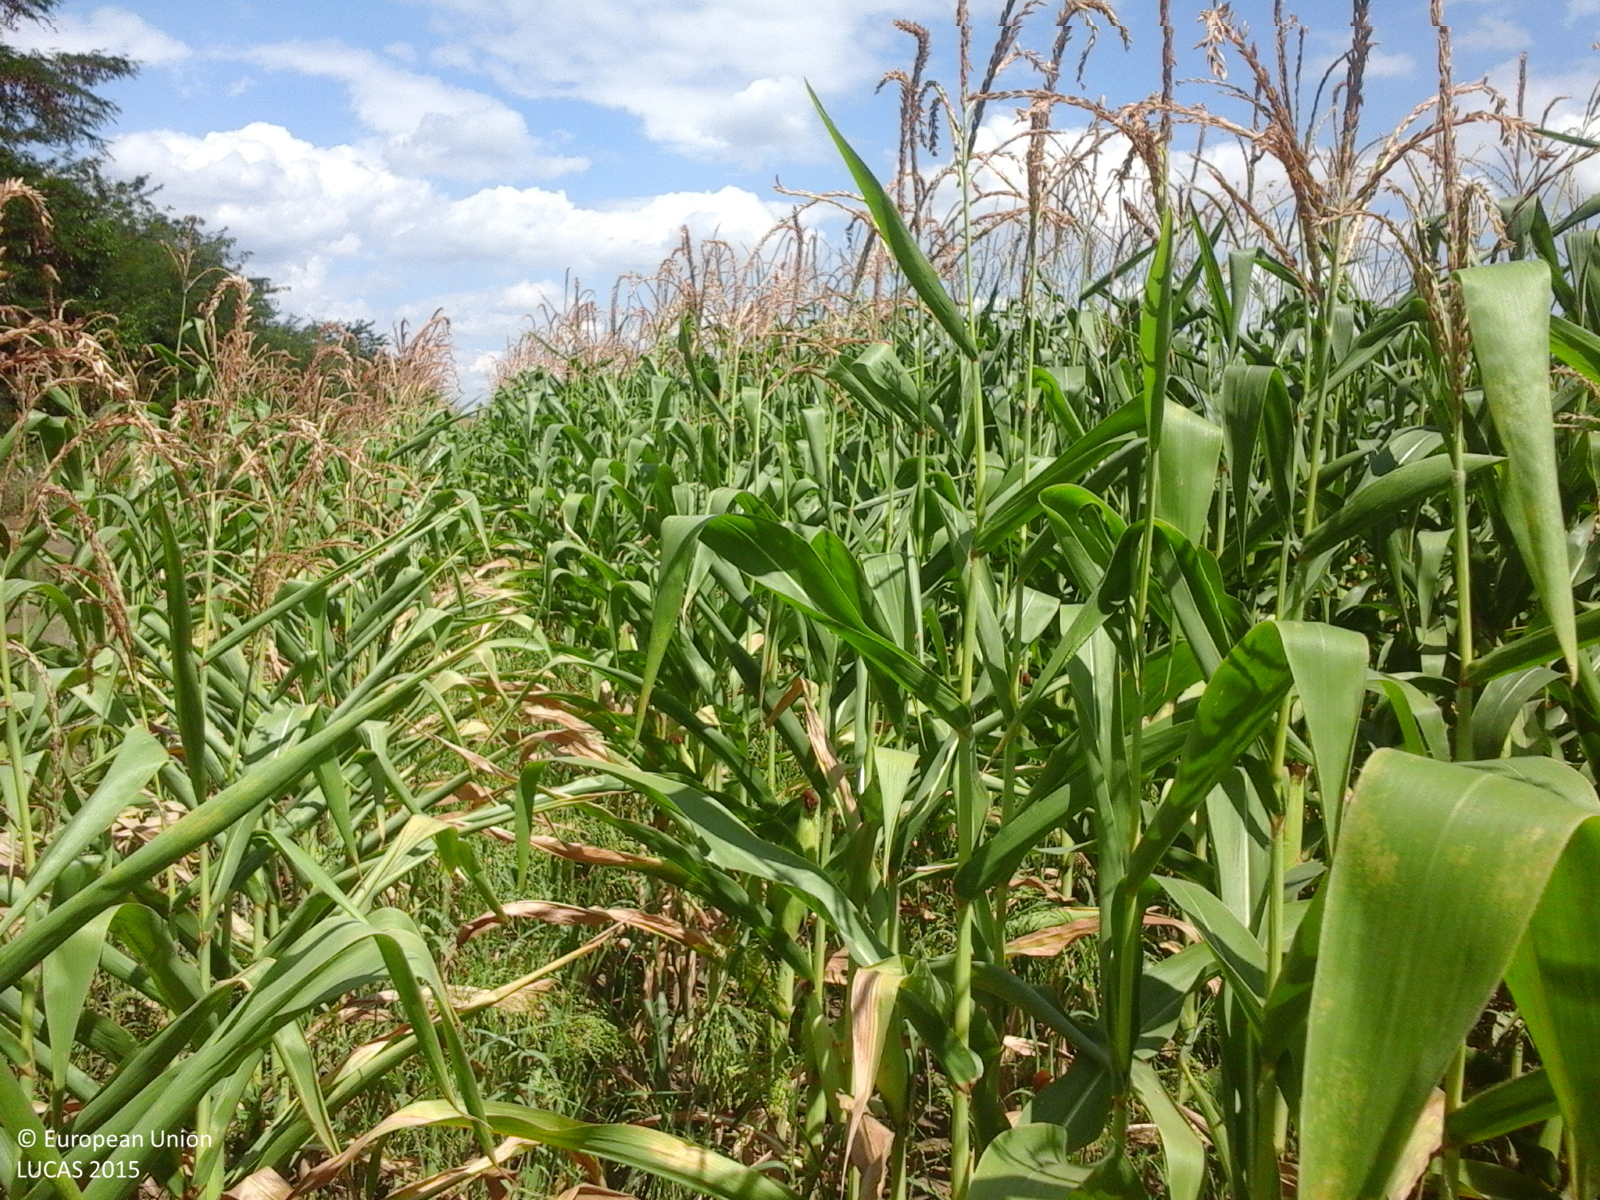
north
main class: Cropland
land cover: Maize
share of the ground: > 75 %
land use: Agriculture (excluding fallow land and kitchen gardens)
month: July
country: RO
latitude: 46.5529
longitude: 27.8203
